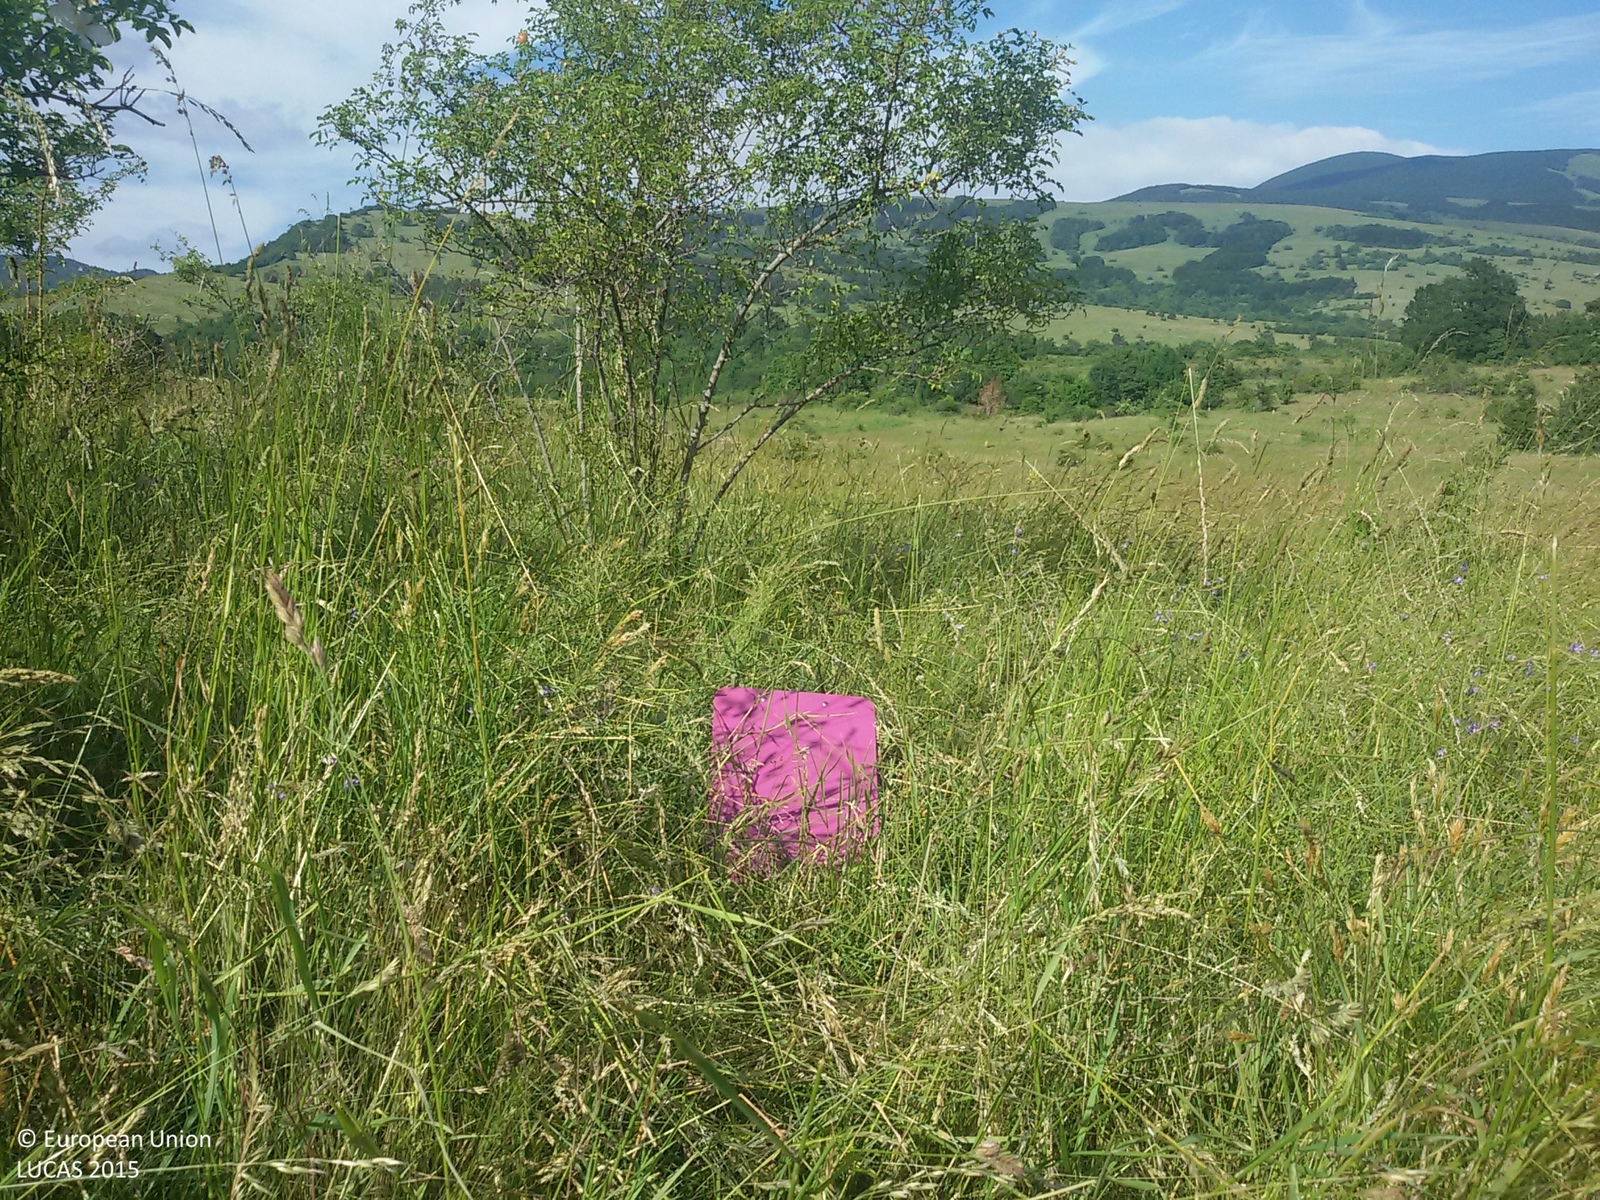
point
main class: Grassland
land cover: Grassland with sparse tree/shrub cover
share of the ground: > 75 %
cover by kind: herbaceous plants 85 %, broadleaved forest trees 5 %, shrubs 5 %, unconsolidated bare surface 5 %
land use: Semi-natural and natural areas not in use
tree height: < 5 m
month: June
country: HR
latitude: 44.5487
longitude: 15.8218
